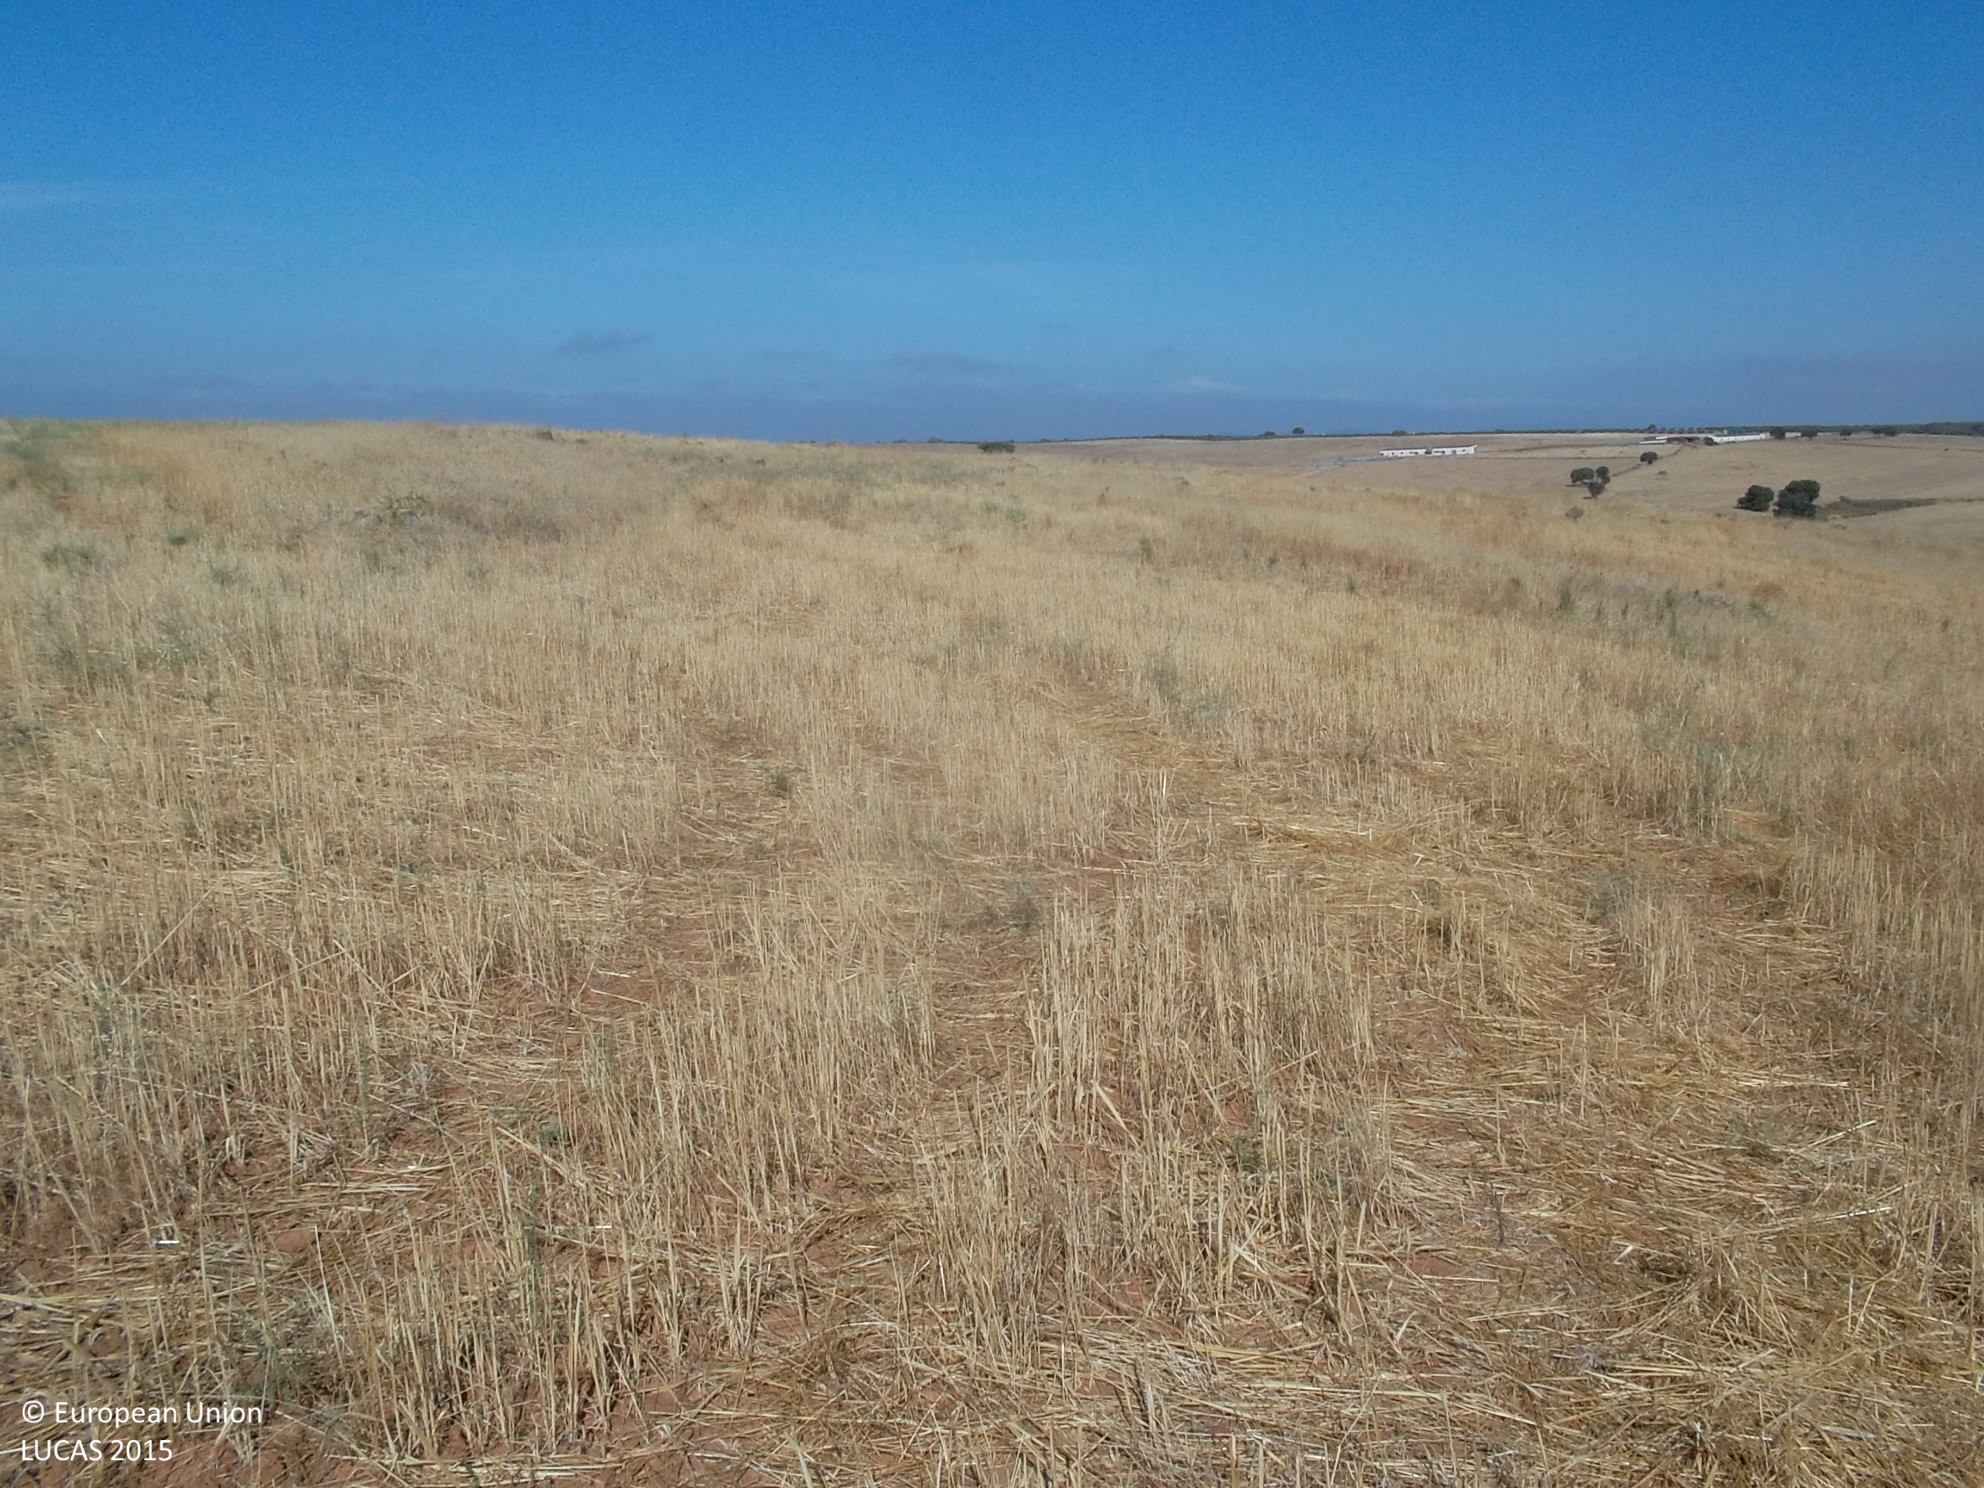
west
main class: Cropland
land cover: Oats
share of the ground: > 75 %
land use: Agriculture (excluding fallow land and kitchen gardens)
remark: Harvested field
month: September
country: ES
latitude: 38.2796
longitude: -6.3362
